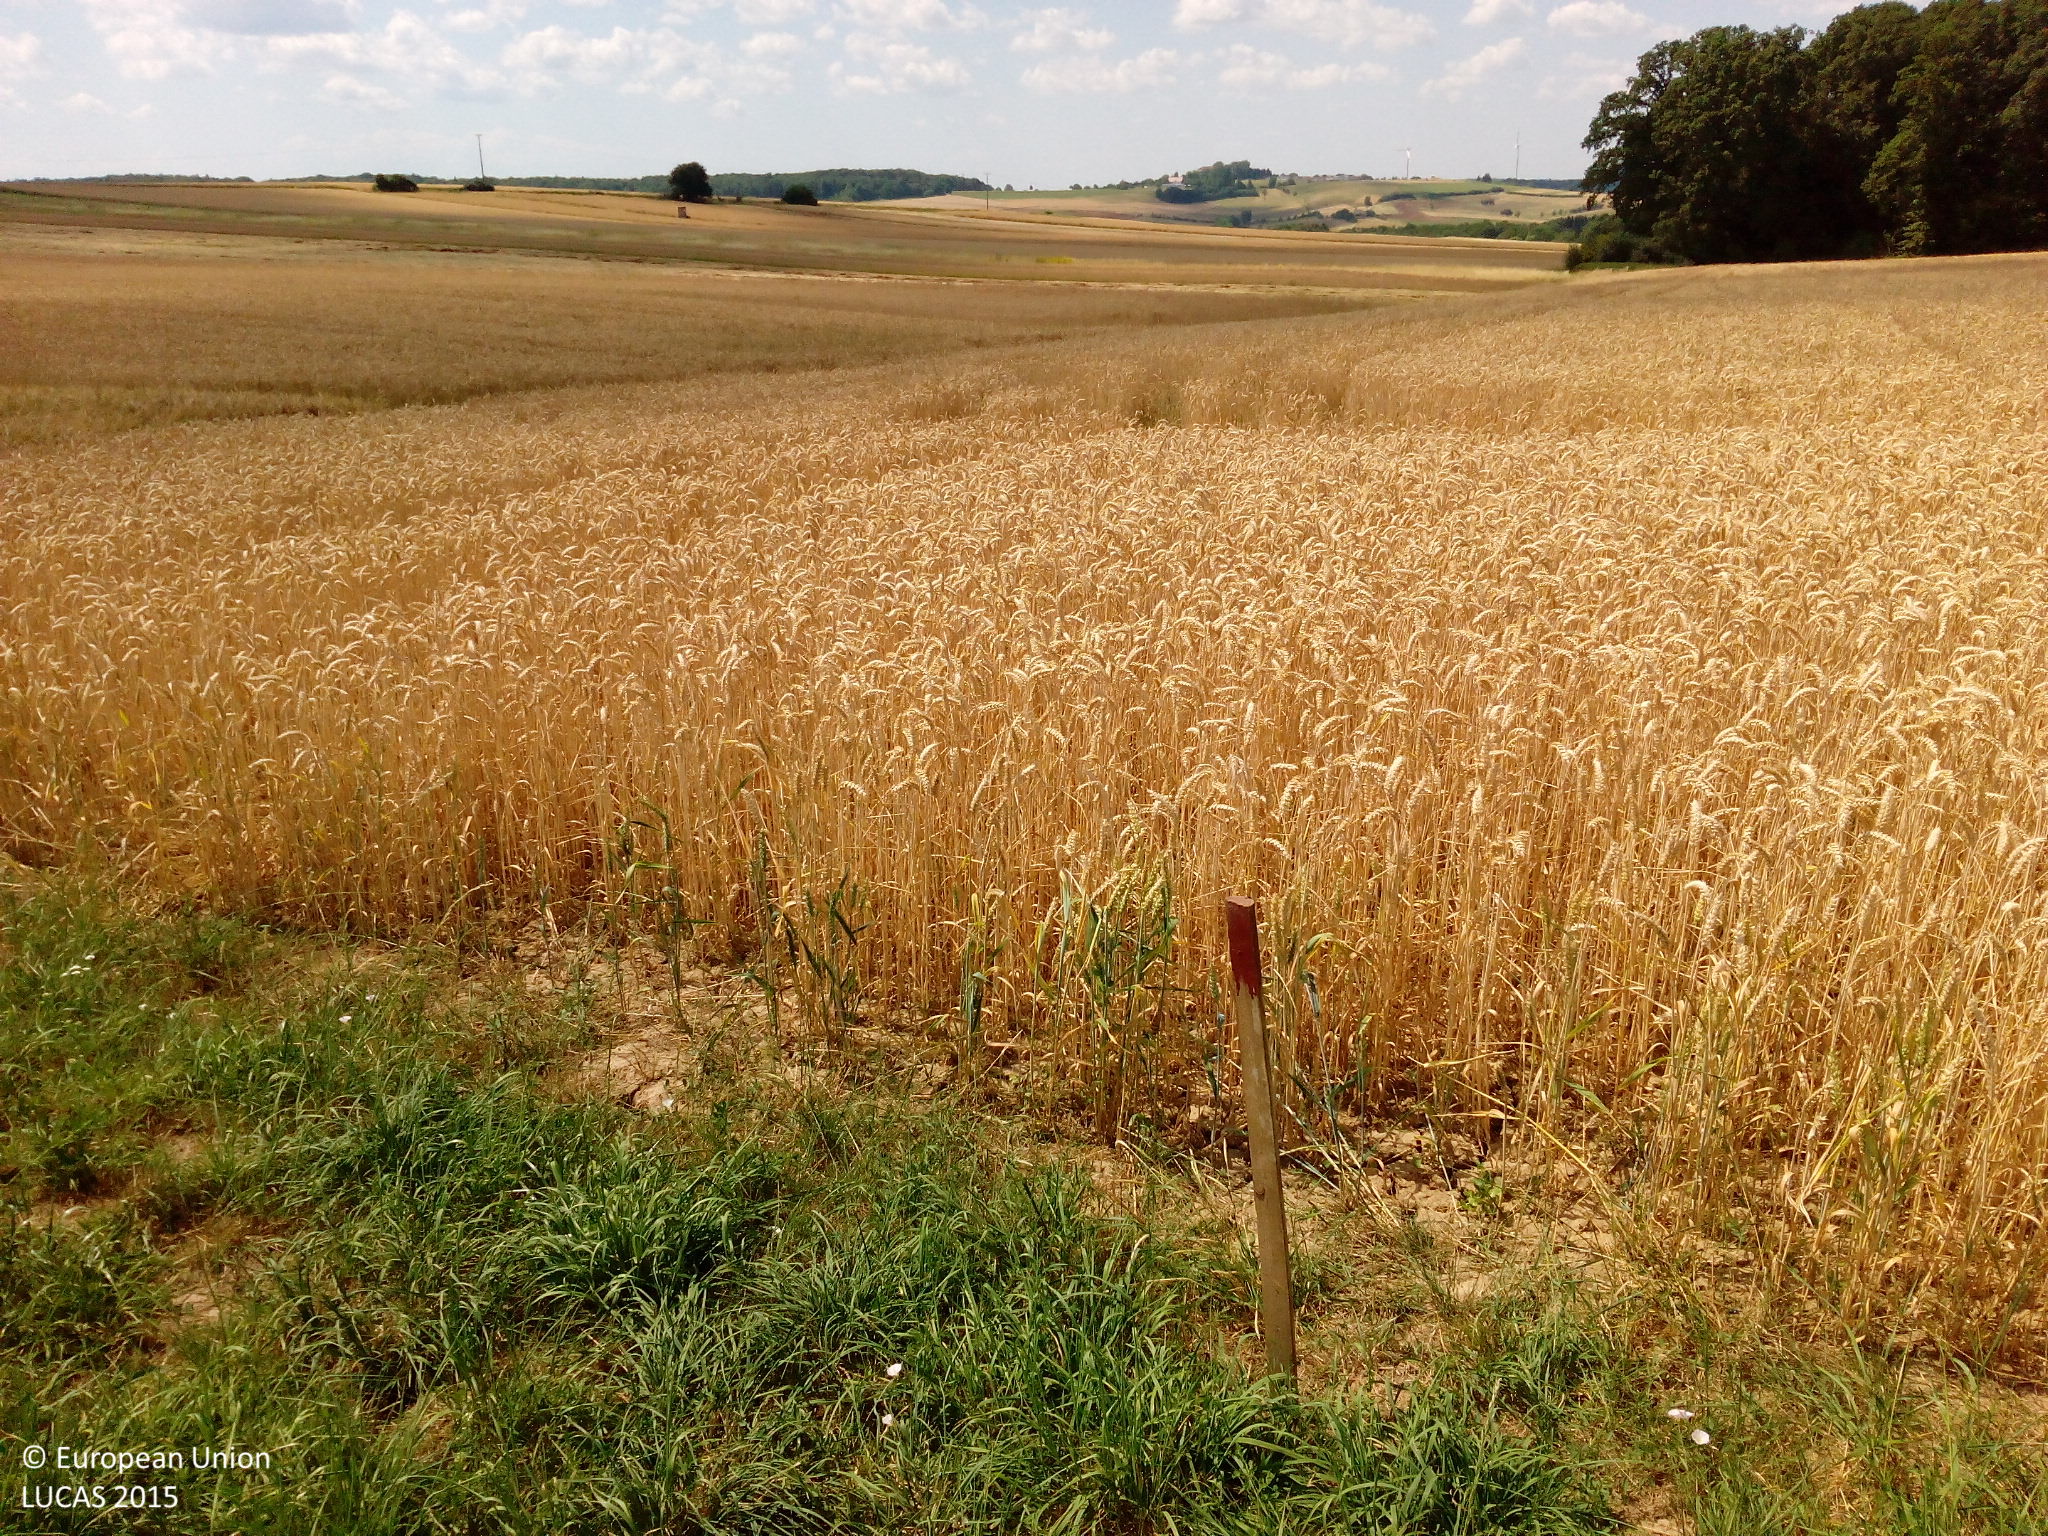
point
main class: Grassland
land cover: Grassland without tree/shrub cover
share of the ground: > 75 %
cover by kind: herbaceous plants 90 %, unconsolidated bare surface 10 %
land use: Agriculture (excluding fallow land and kitchen gardens)
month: July
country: DE
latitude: 49.2401
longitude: 7.5419
